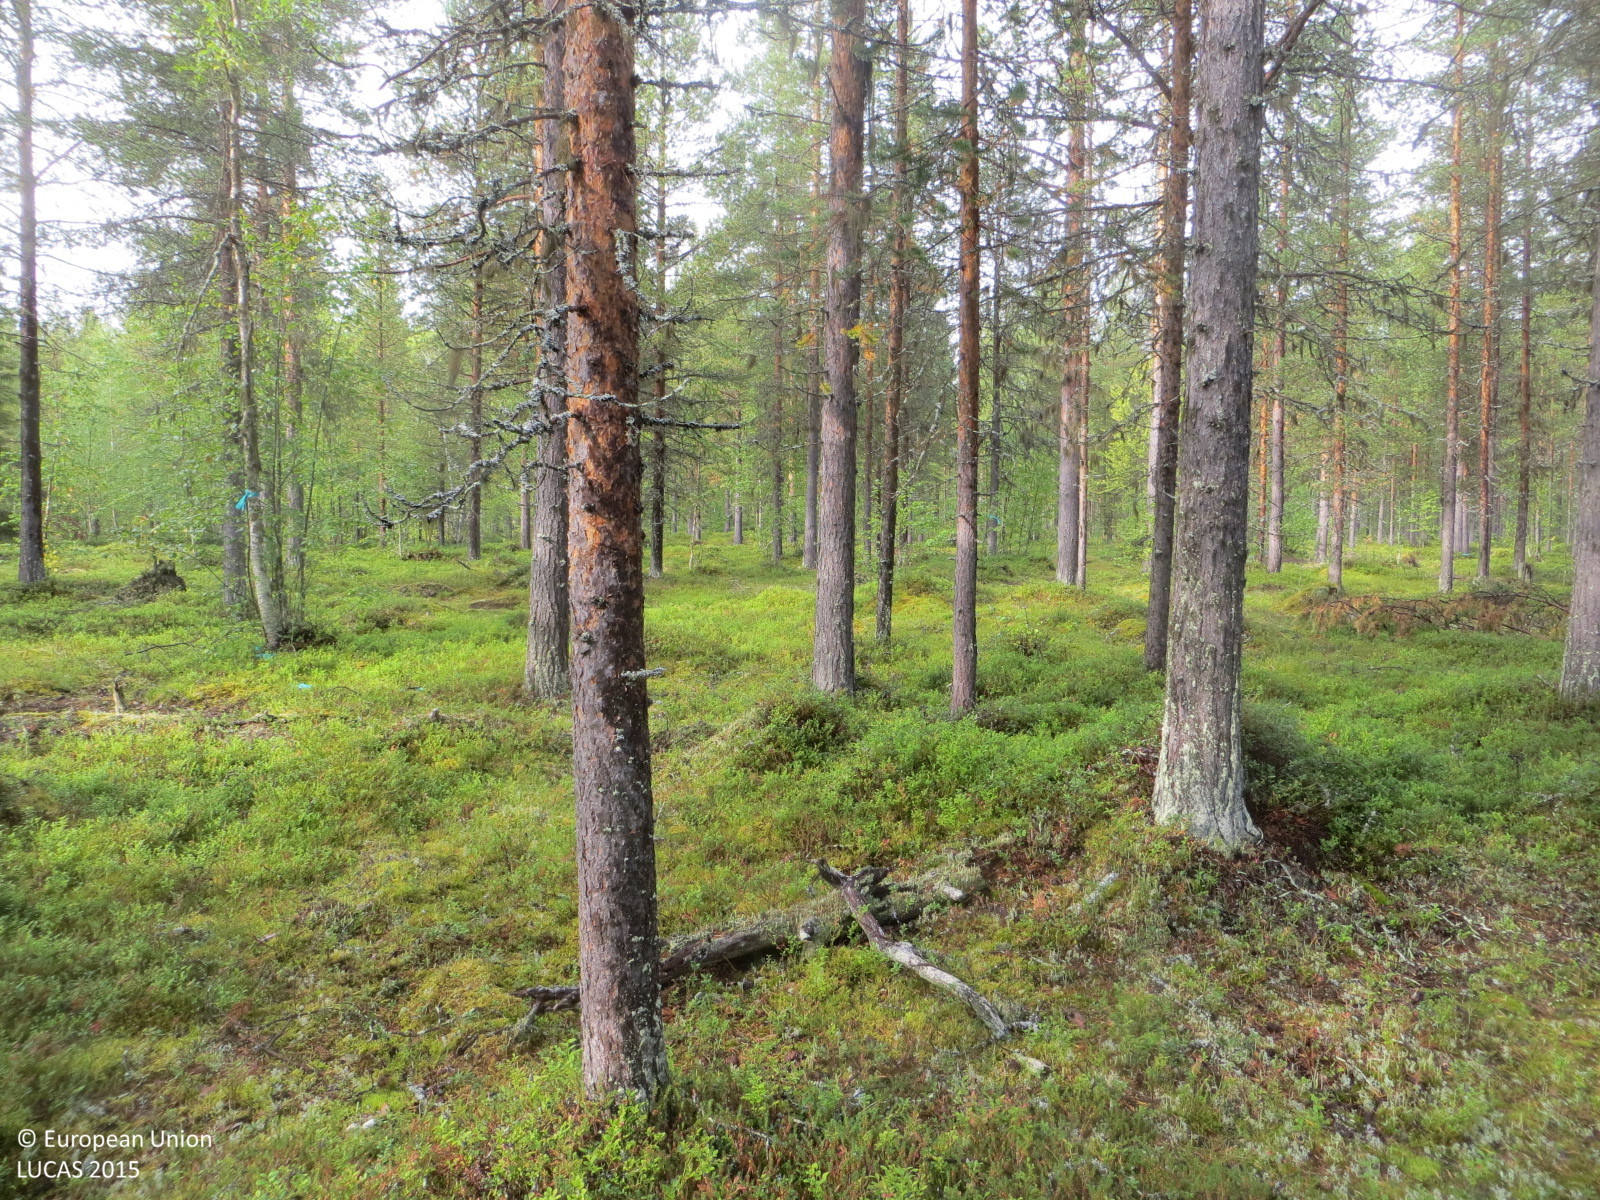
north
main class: Woodland
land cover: Pine dominated coniferous woodland
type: boreal forest
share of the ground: 50 - 75 %
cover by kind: coniferous forest trees 50 %, shrubs 50 %
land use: Forestry
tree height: > 5 m
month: August
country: FI
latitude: 67.8708
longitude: 24.6576
